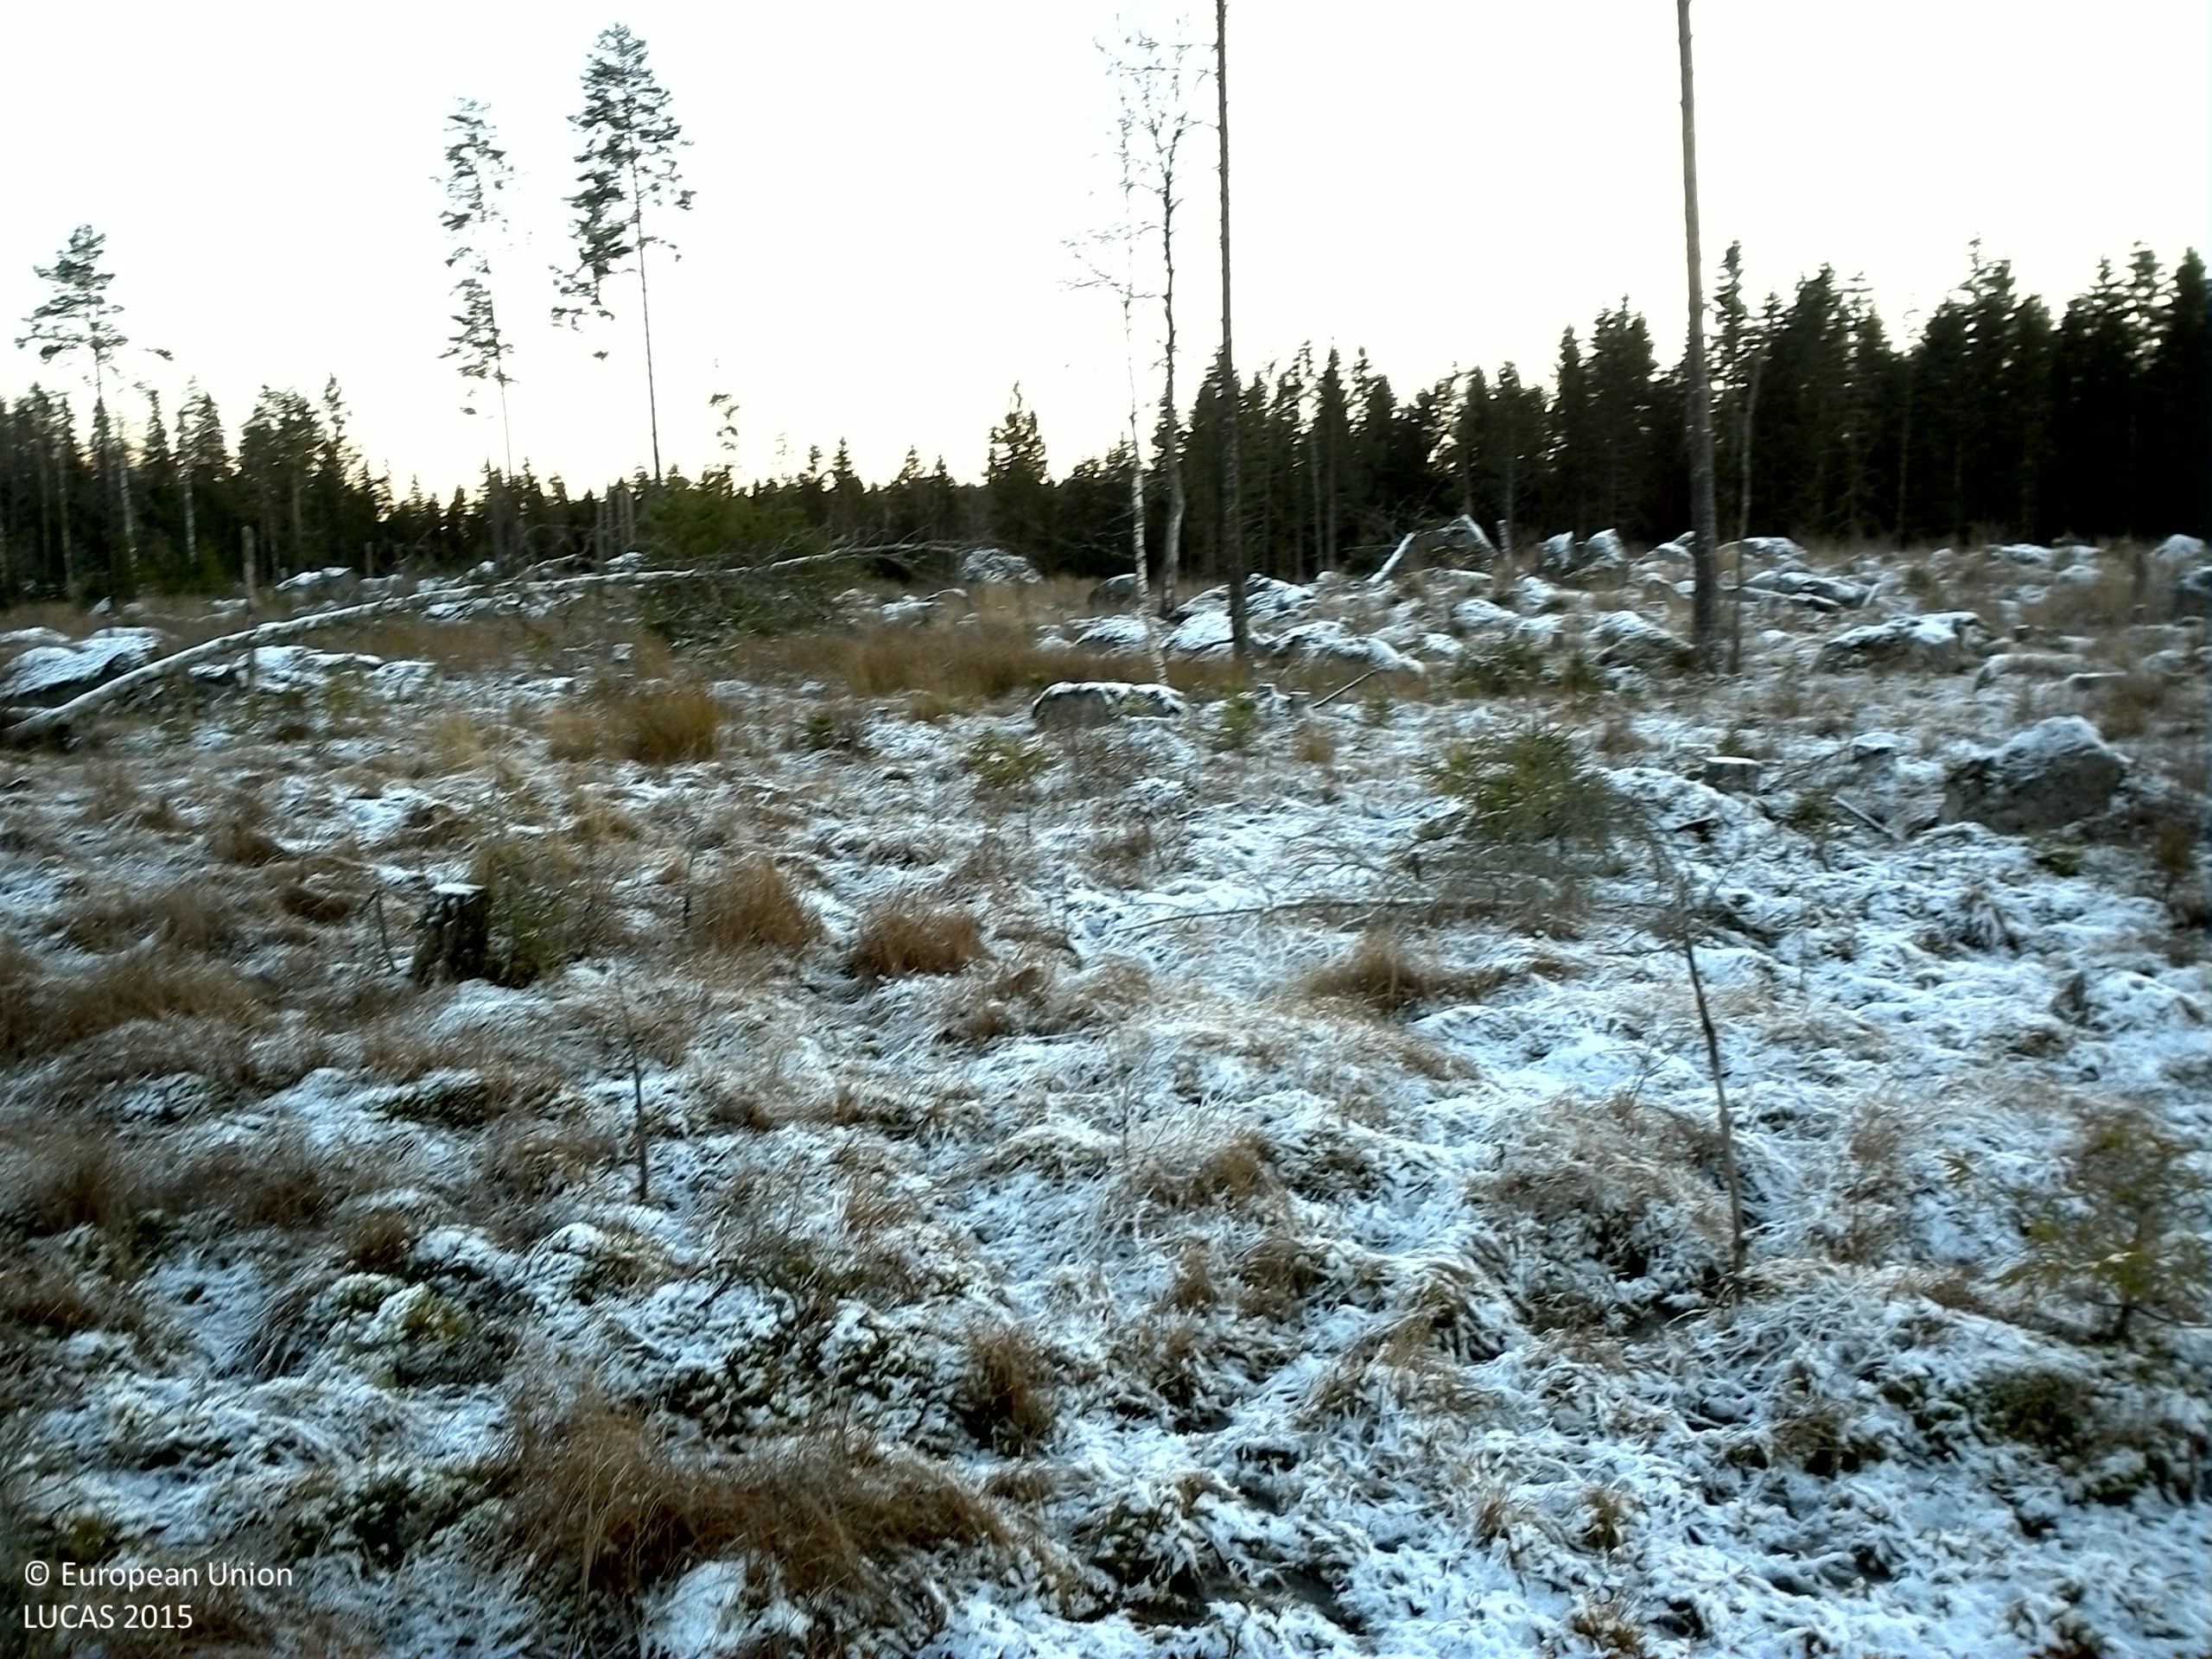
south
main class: Grassland
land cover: Grassland with sparse tree/shrub cover
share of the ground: 50 - 75 %
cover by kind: herbaceous plants 55 %, lichens and mosses 20 %, shrubs 10 %, consolidated bare surface 10 %, broadleaved forest trees 5 %
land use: Forestry
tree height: > 5 m
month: November
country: SE
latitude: 59.7652
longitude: 16.3830
